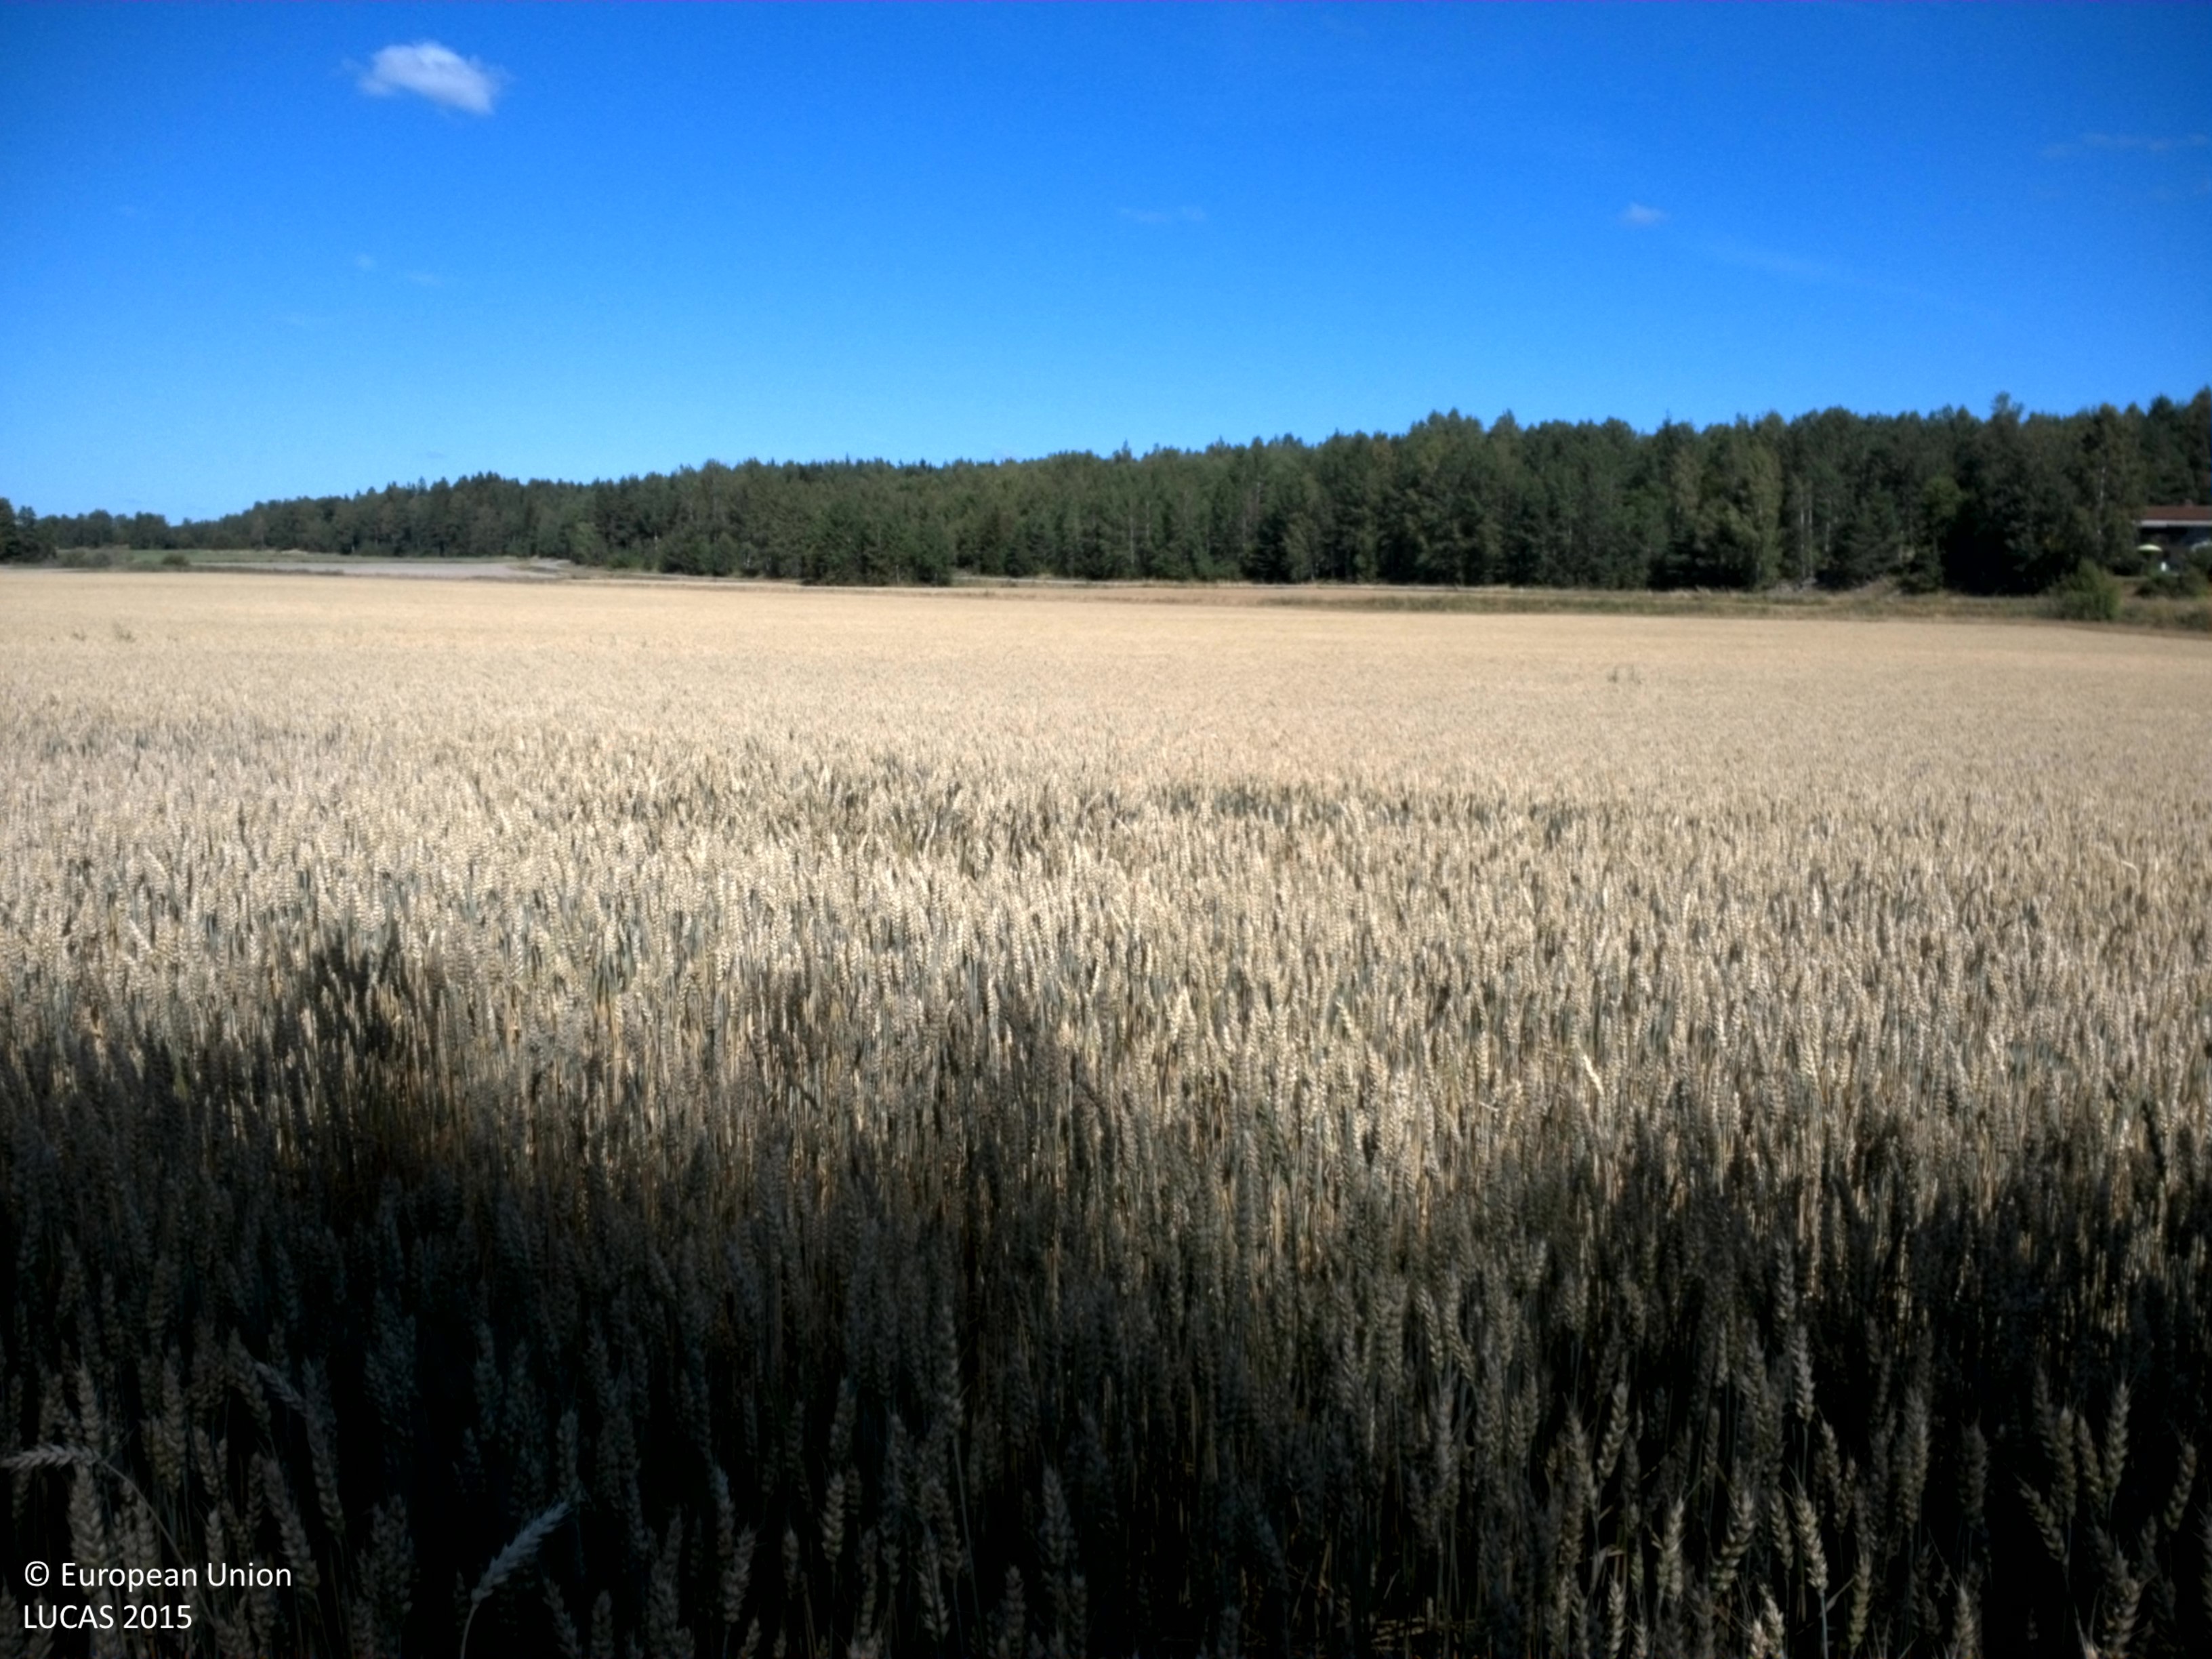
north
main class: Cropland
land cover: Common wheat
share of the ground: > 75 %
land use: Agriculture (excluding fallow land and kitchen gardens)
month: August
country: SE
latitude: 60.0269
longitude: 17.9804
